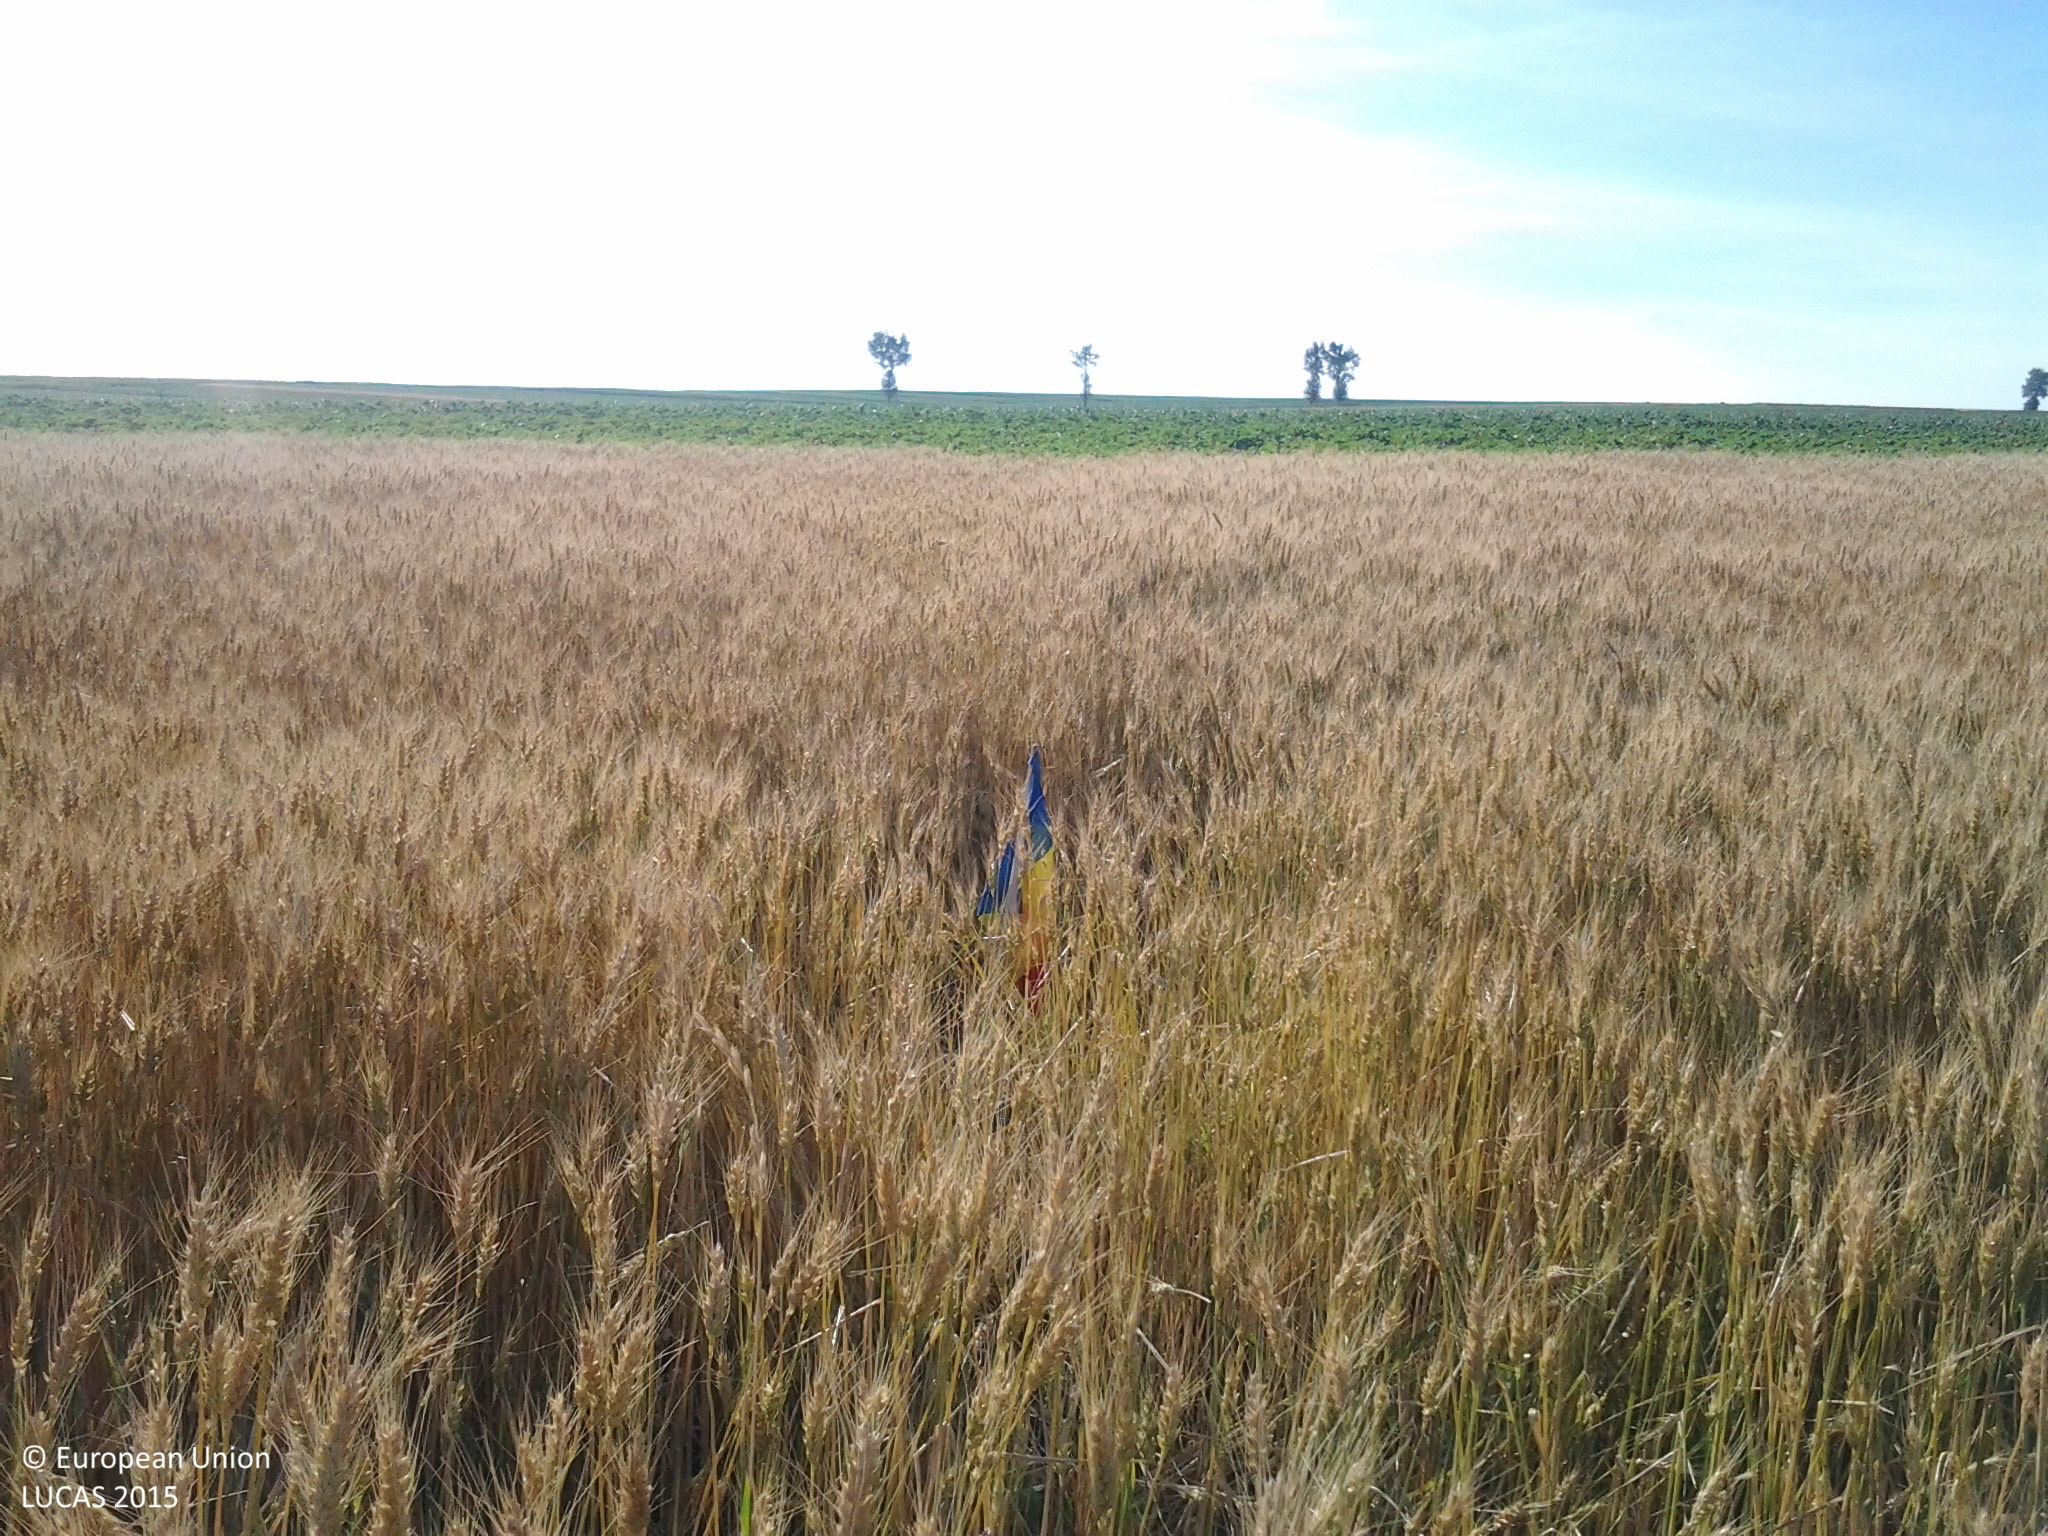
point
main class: Cropland
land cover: Durum wheat
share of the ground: > 75 %
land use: Agriculture (excluding fallow land and kitchen gardens)
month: June
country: RO
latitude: 47.1689
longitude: 26.8648
